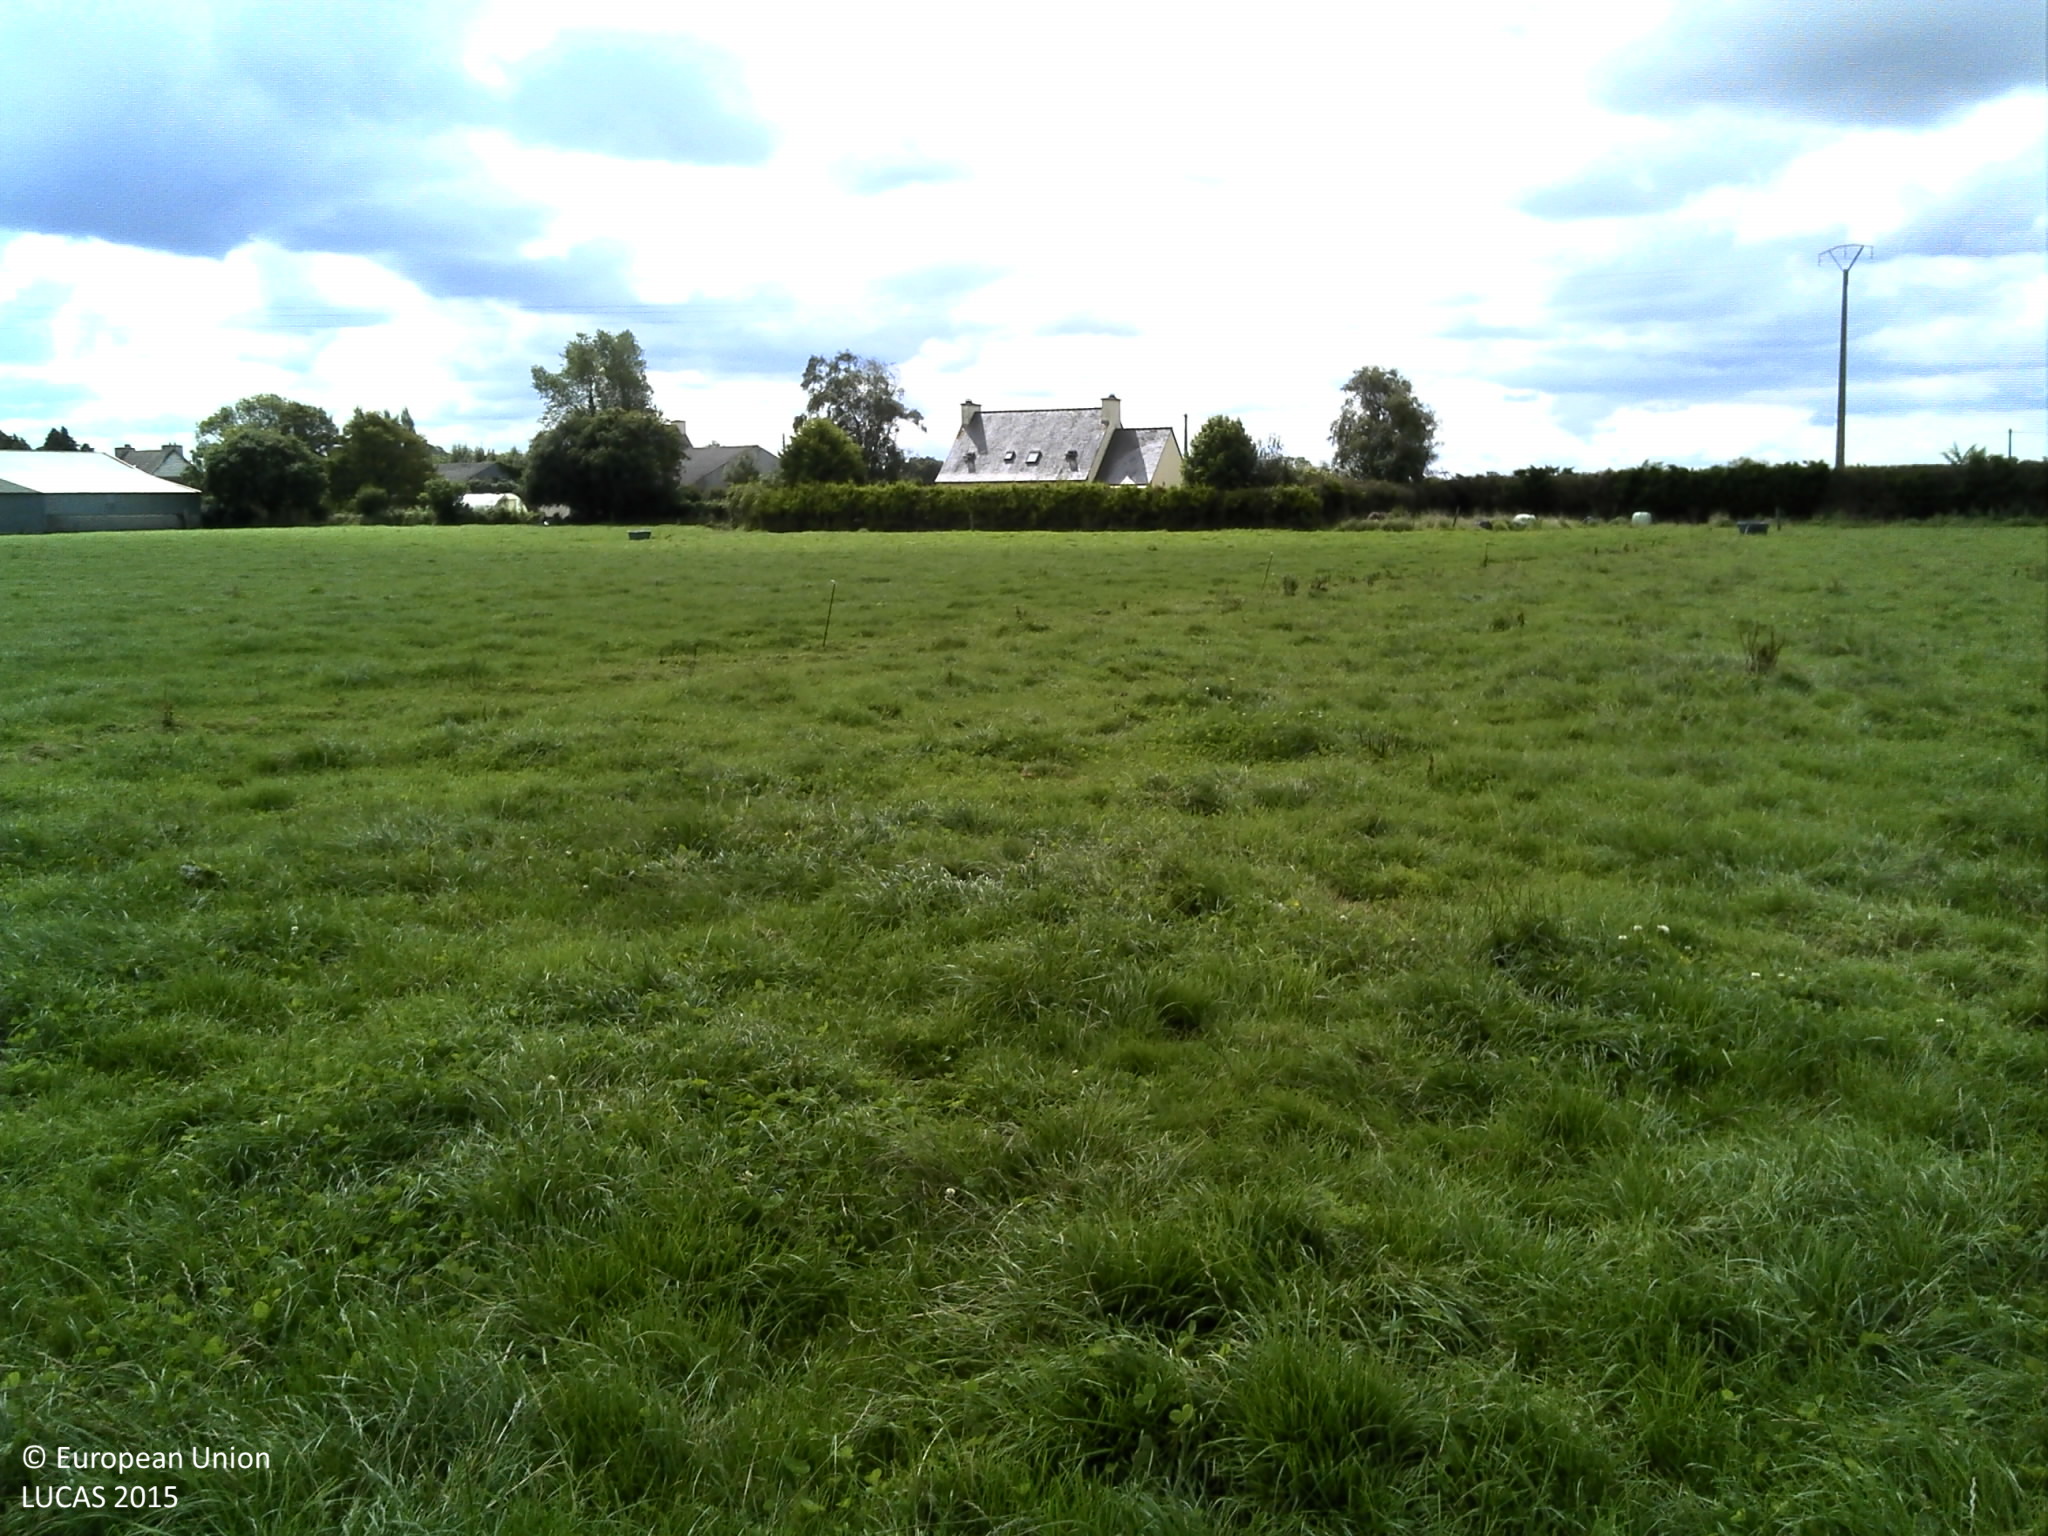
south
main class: Grassland
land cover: Grassland without tree/shrub cover
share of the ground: > 75 %
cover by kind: herbaceous plants 100 %
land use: Agriculture (excluding fallow land and kitchen gardens)
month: September
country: FR
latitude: 48.5205
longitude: -4.2145
